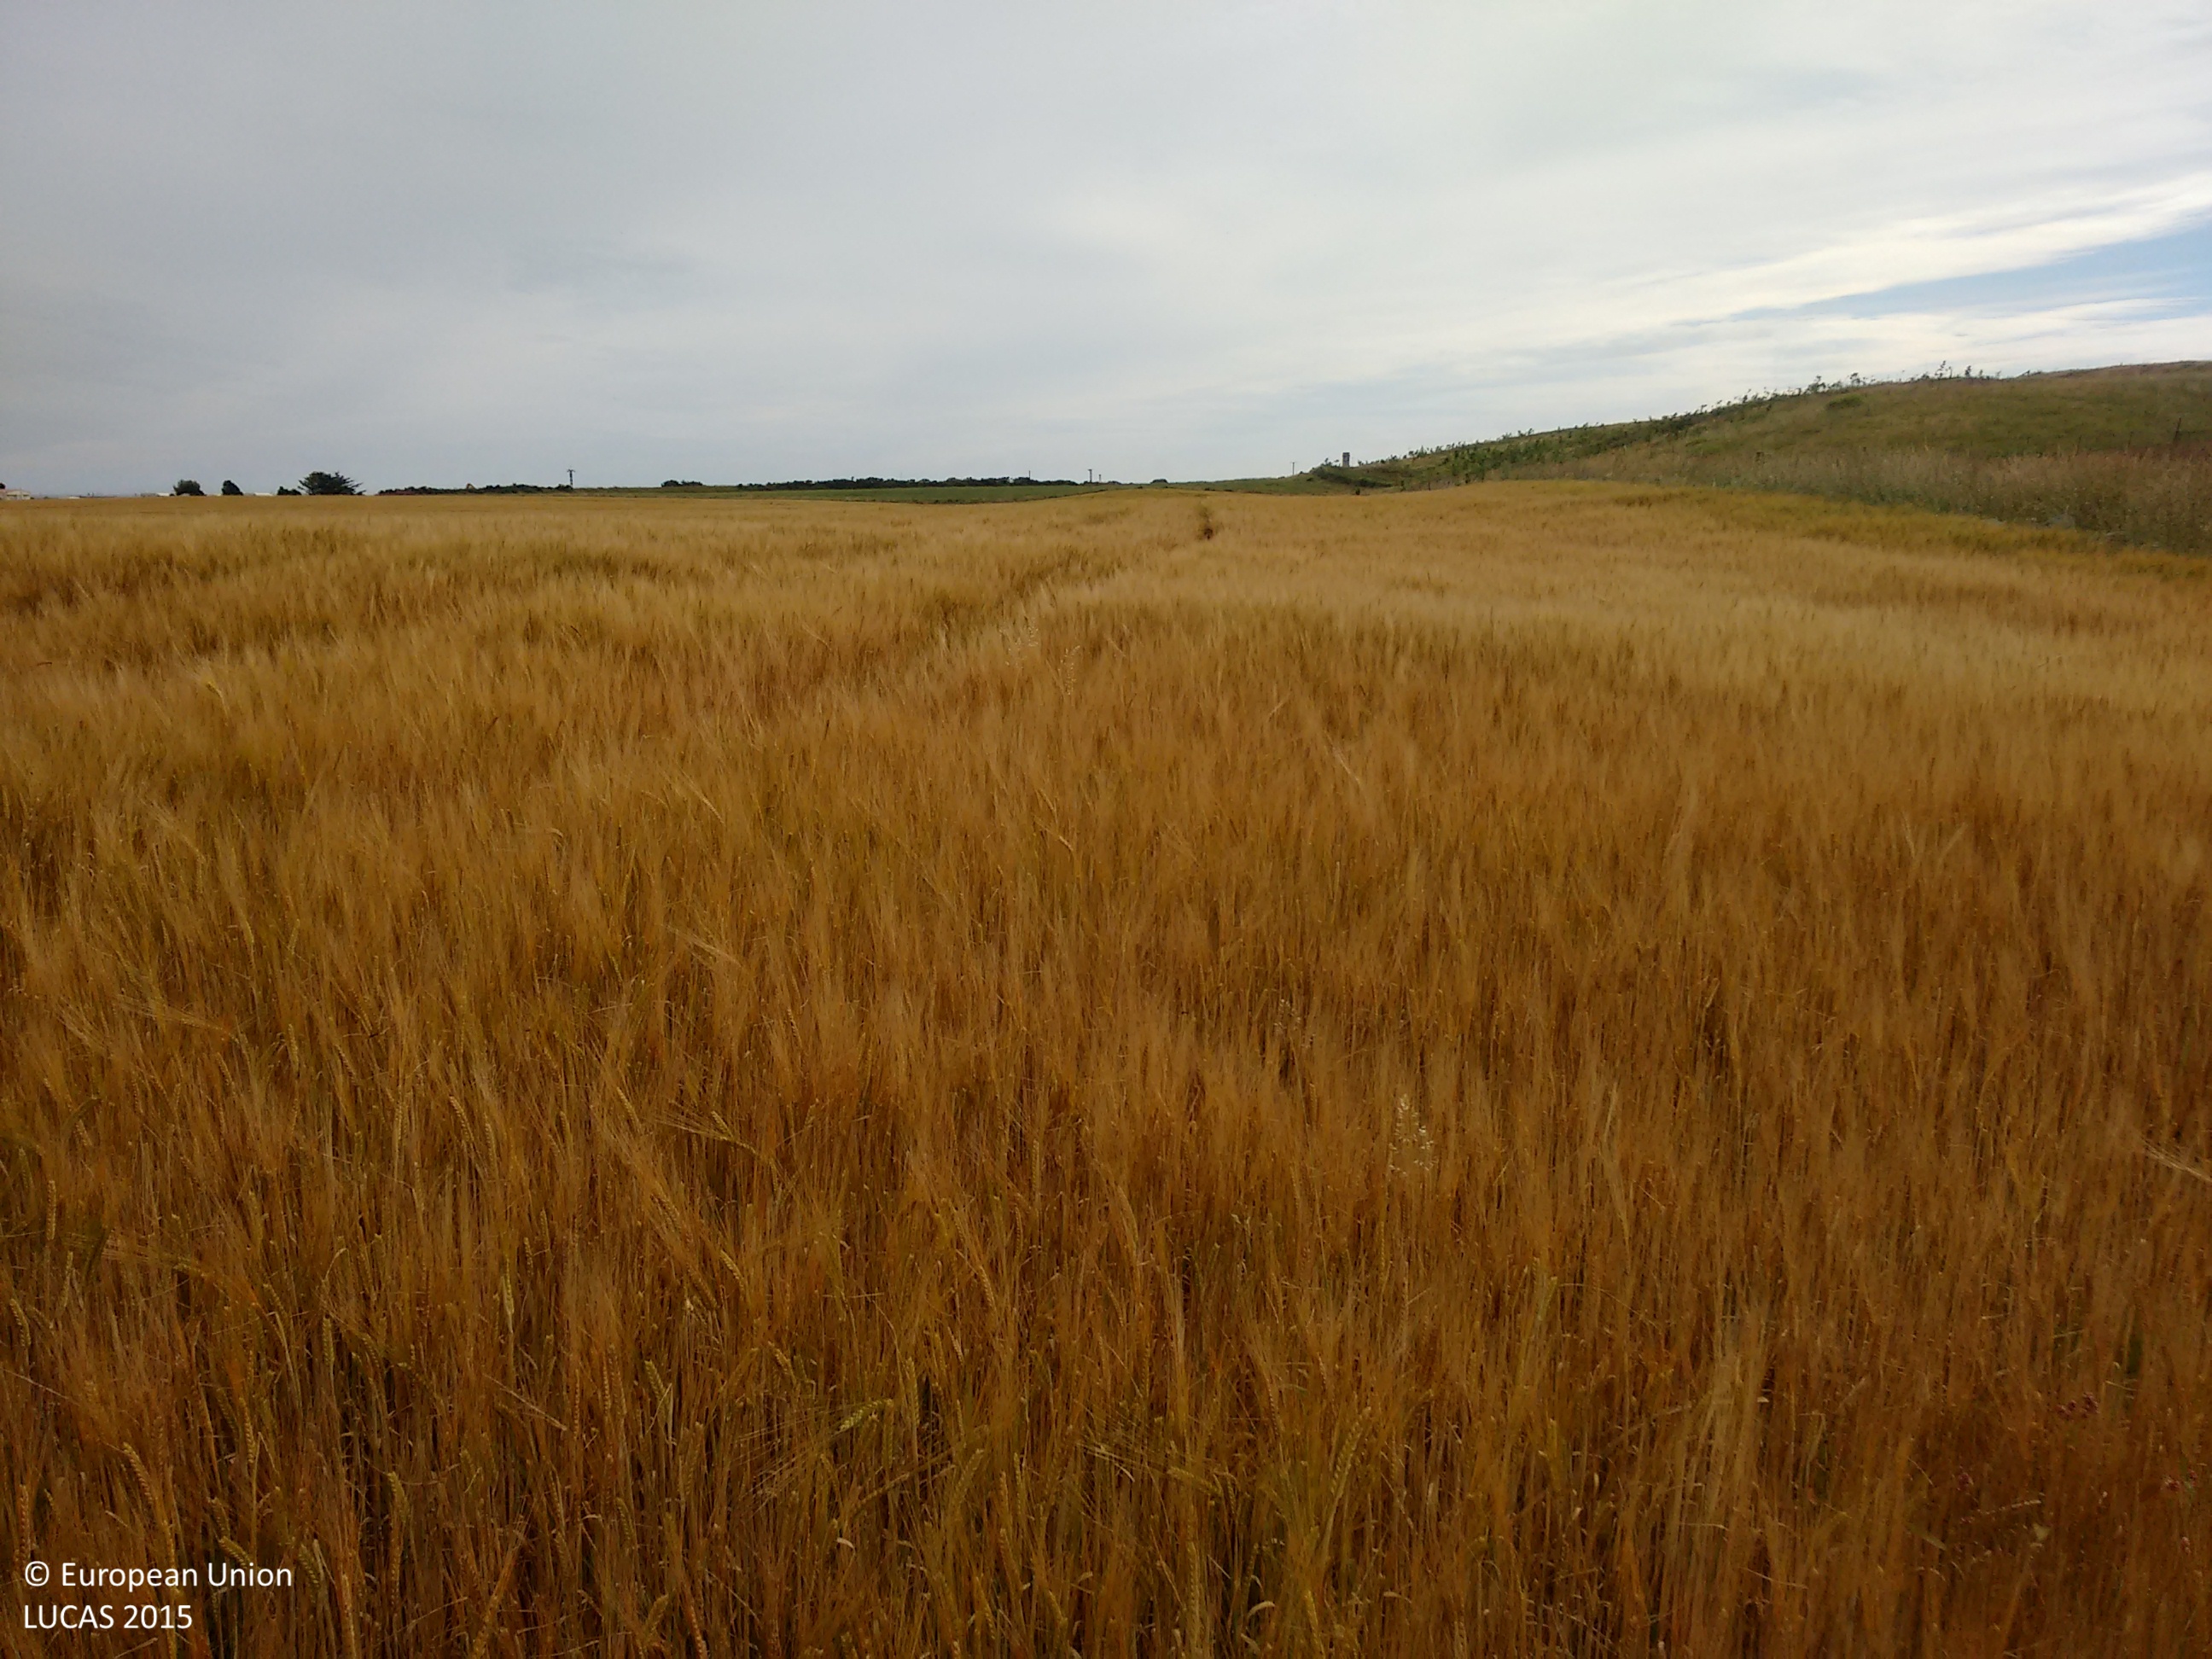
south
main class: Cropland
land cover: Barley
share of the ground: > 75 %
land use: Agriculture (excluding fallow land and kitchen gardens)
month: August
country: GB
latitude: 57.2163
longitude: -2.0860
